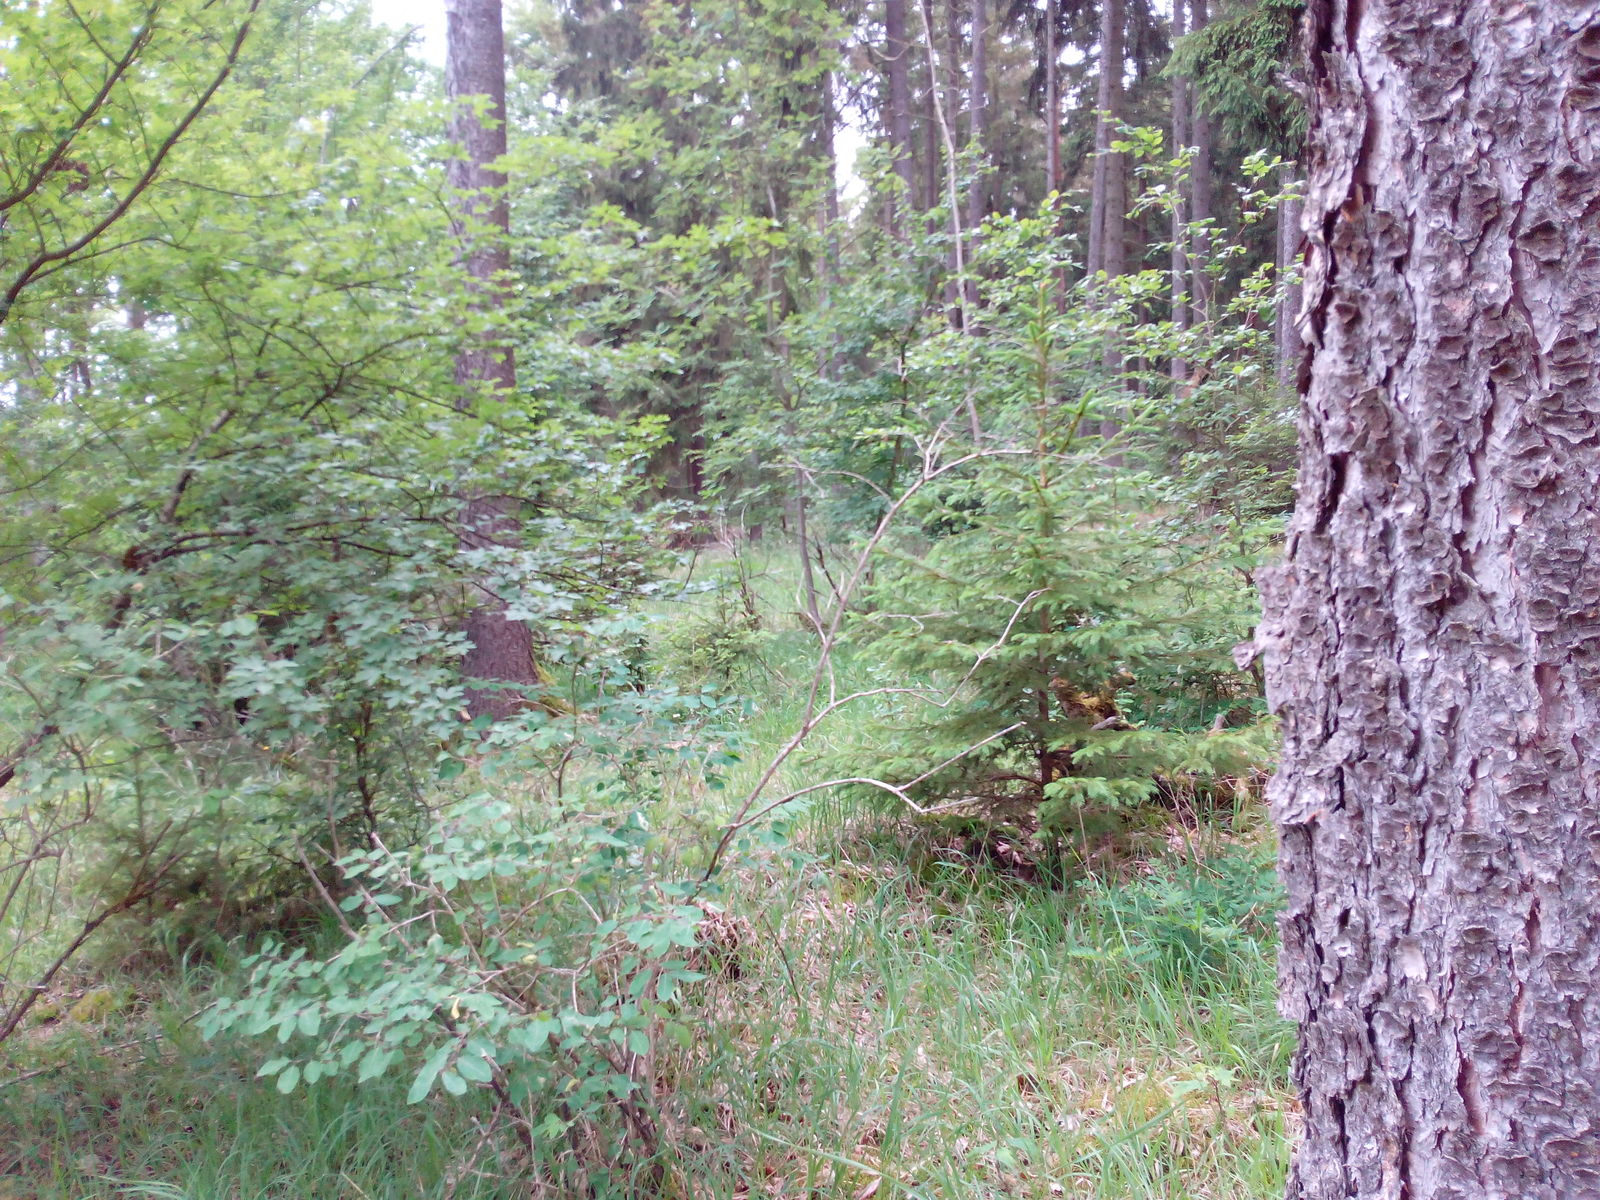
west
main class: Woodland
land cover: Spruce dominated coniferous woodland
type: hemiboreal forest and nemoral coniferous forest and mixed broadleaved-coniferous forest
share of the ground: 50 - 75 %
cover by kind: coniferous forest trees 60 %, herbaceous plants 30 %, shrubs 10 %
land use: Forestry
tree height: > 5 m
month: June
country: DE
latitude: 50.4522
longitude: 10.6336
